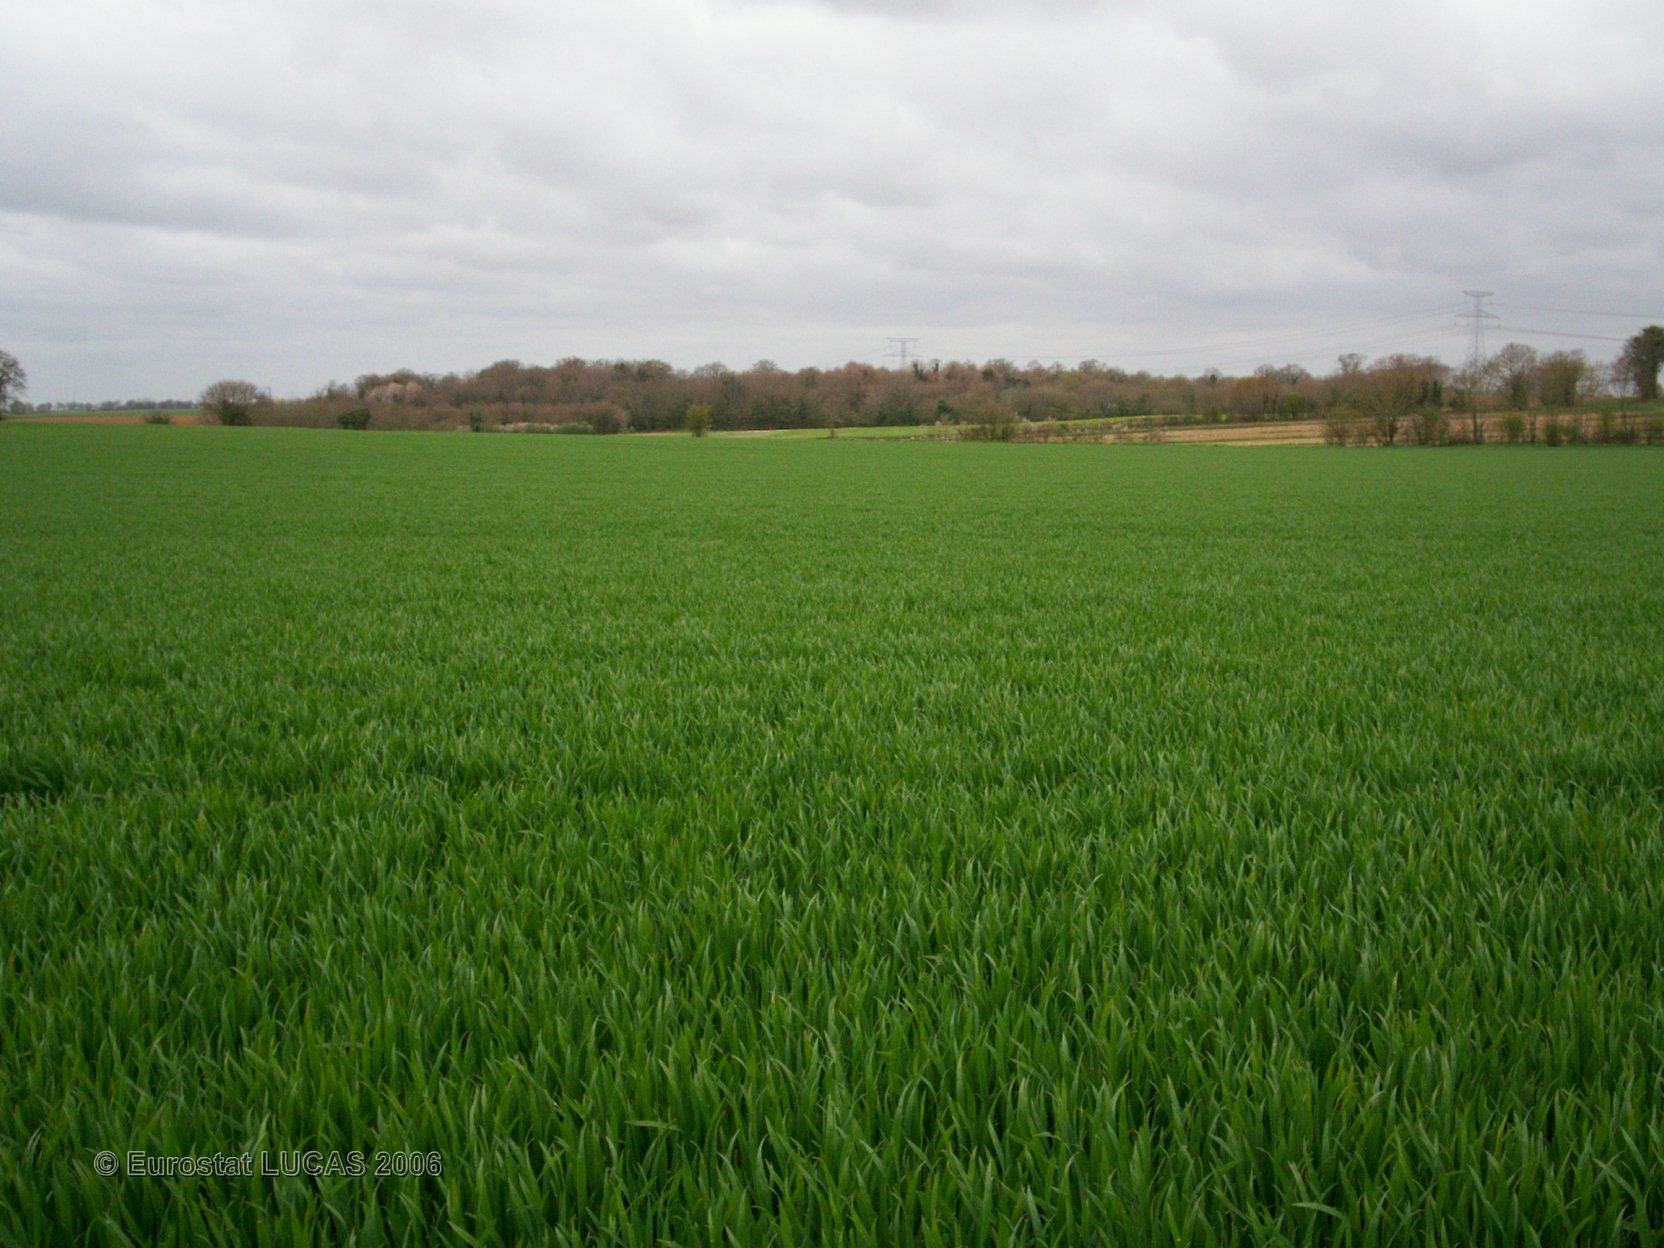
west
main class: Cropland
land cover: Common wheat
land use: Agriculture (excluding fallow land and kitchen gardens)
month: April
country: FR
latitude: 46.2788
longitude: -0.2102
